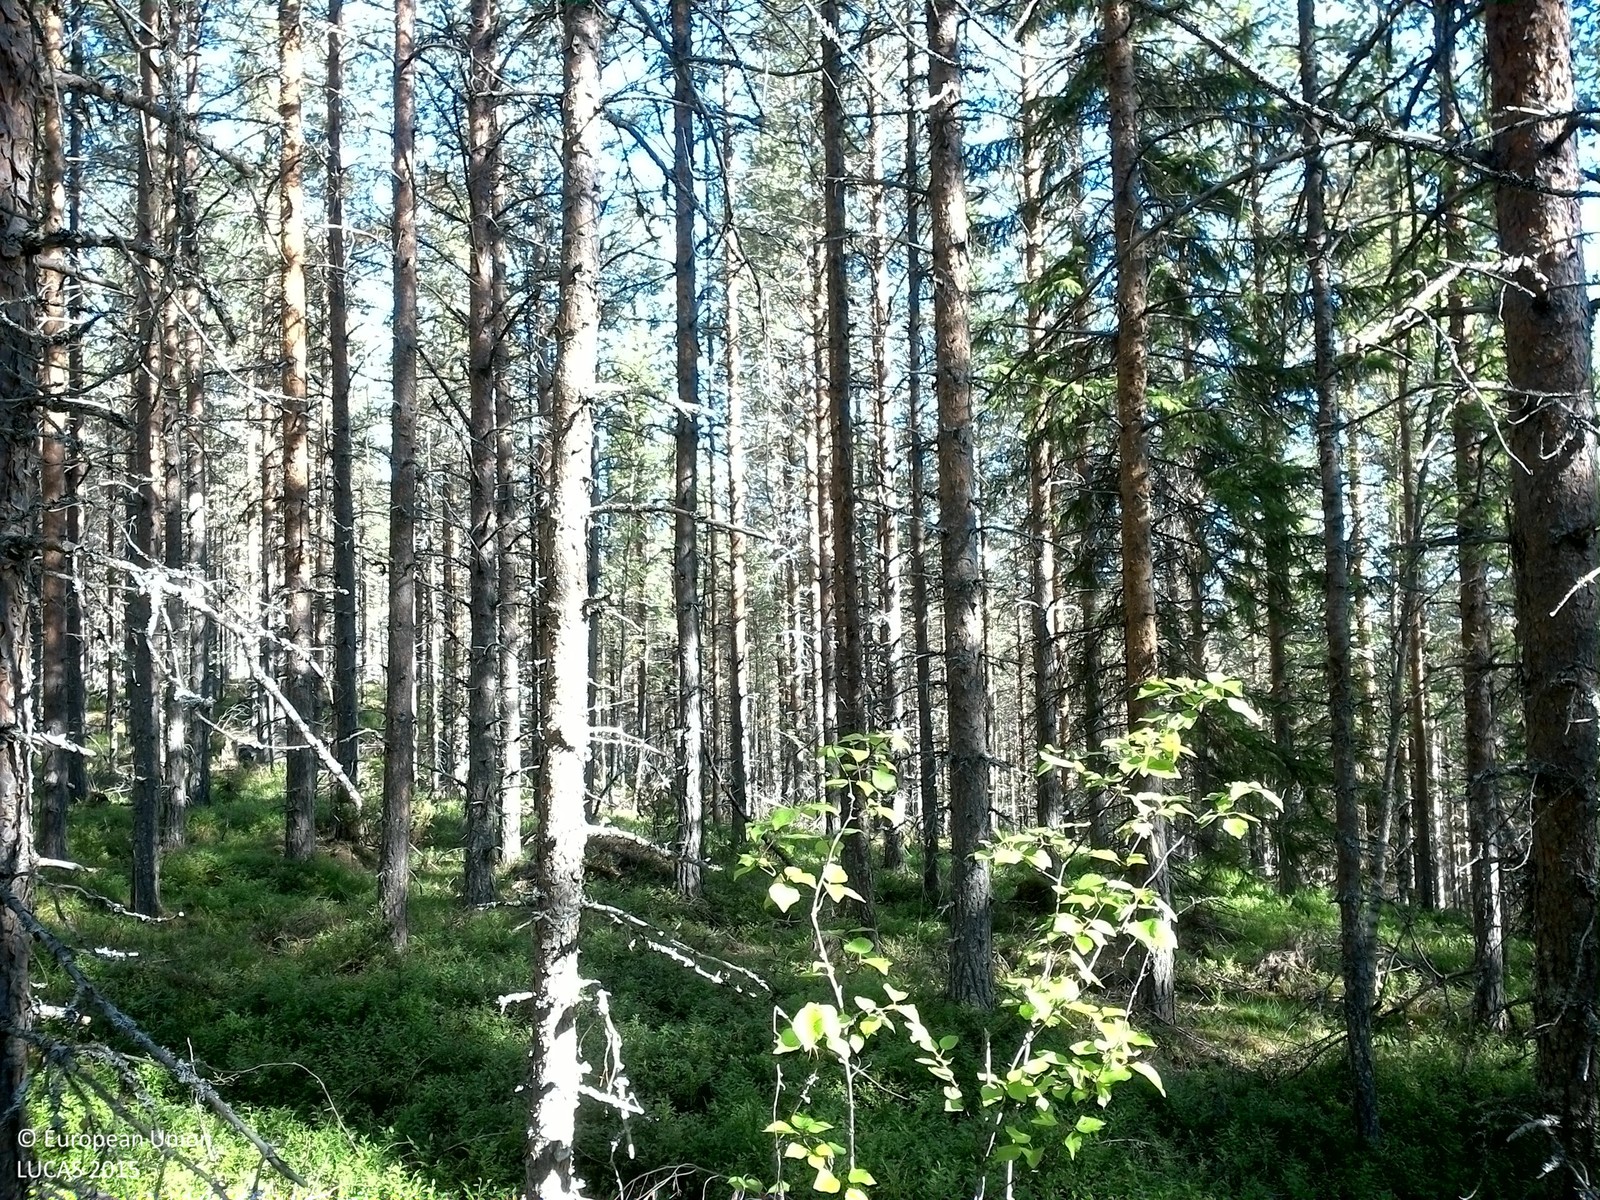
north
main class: Woodland
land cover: Pine dominated coniferous woodland
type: boreal forest
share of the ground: > 75 %
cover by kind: coniferous forest trees 75 %, shrubs 25 %
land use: Forestry
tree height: > 5 m
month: August
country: SE
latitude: 63.6601
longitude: 17.8315
